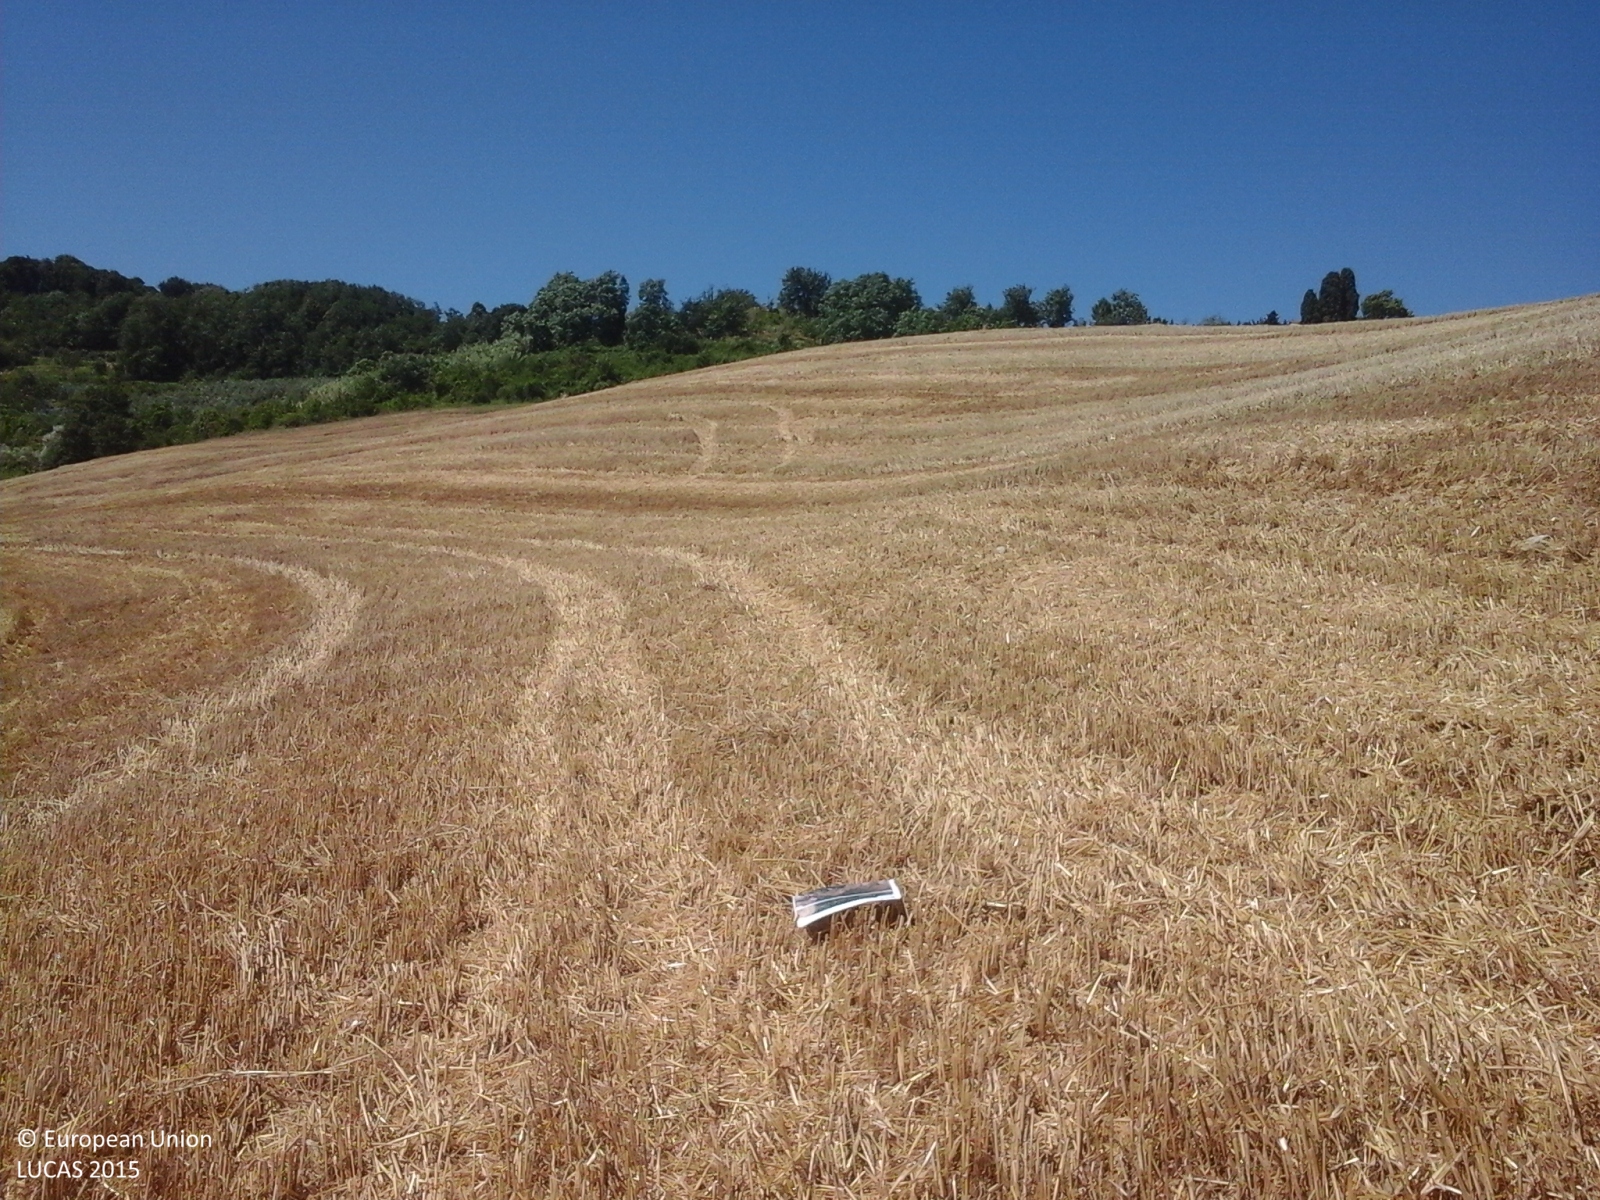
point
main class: Cropland
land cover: Durum wheat
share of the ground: > 75 %
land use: Agriculture (excluding fallow land and kitchen gardens)
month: June
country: IT
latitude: 43.5369
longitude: 10.6047
